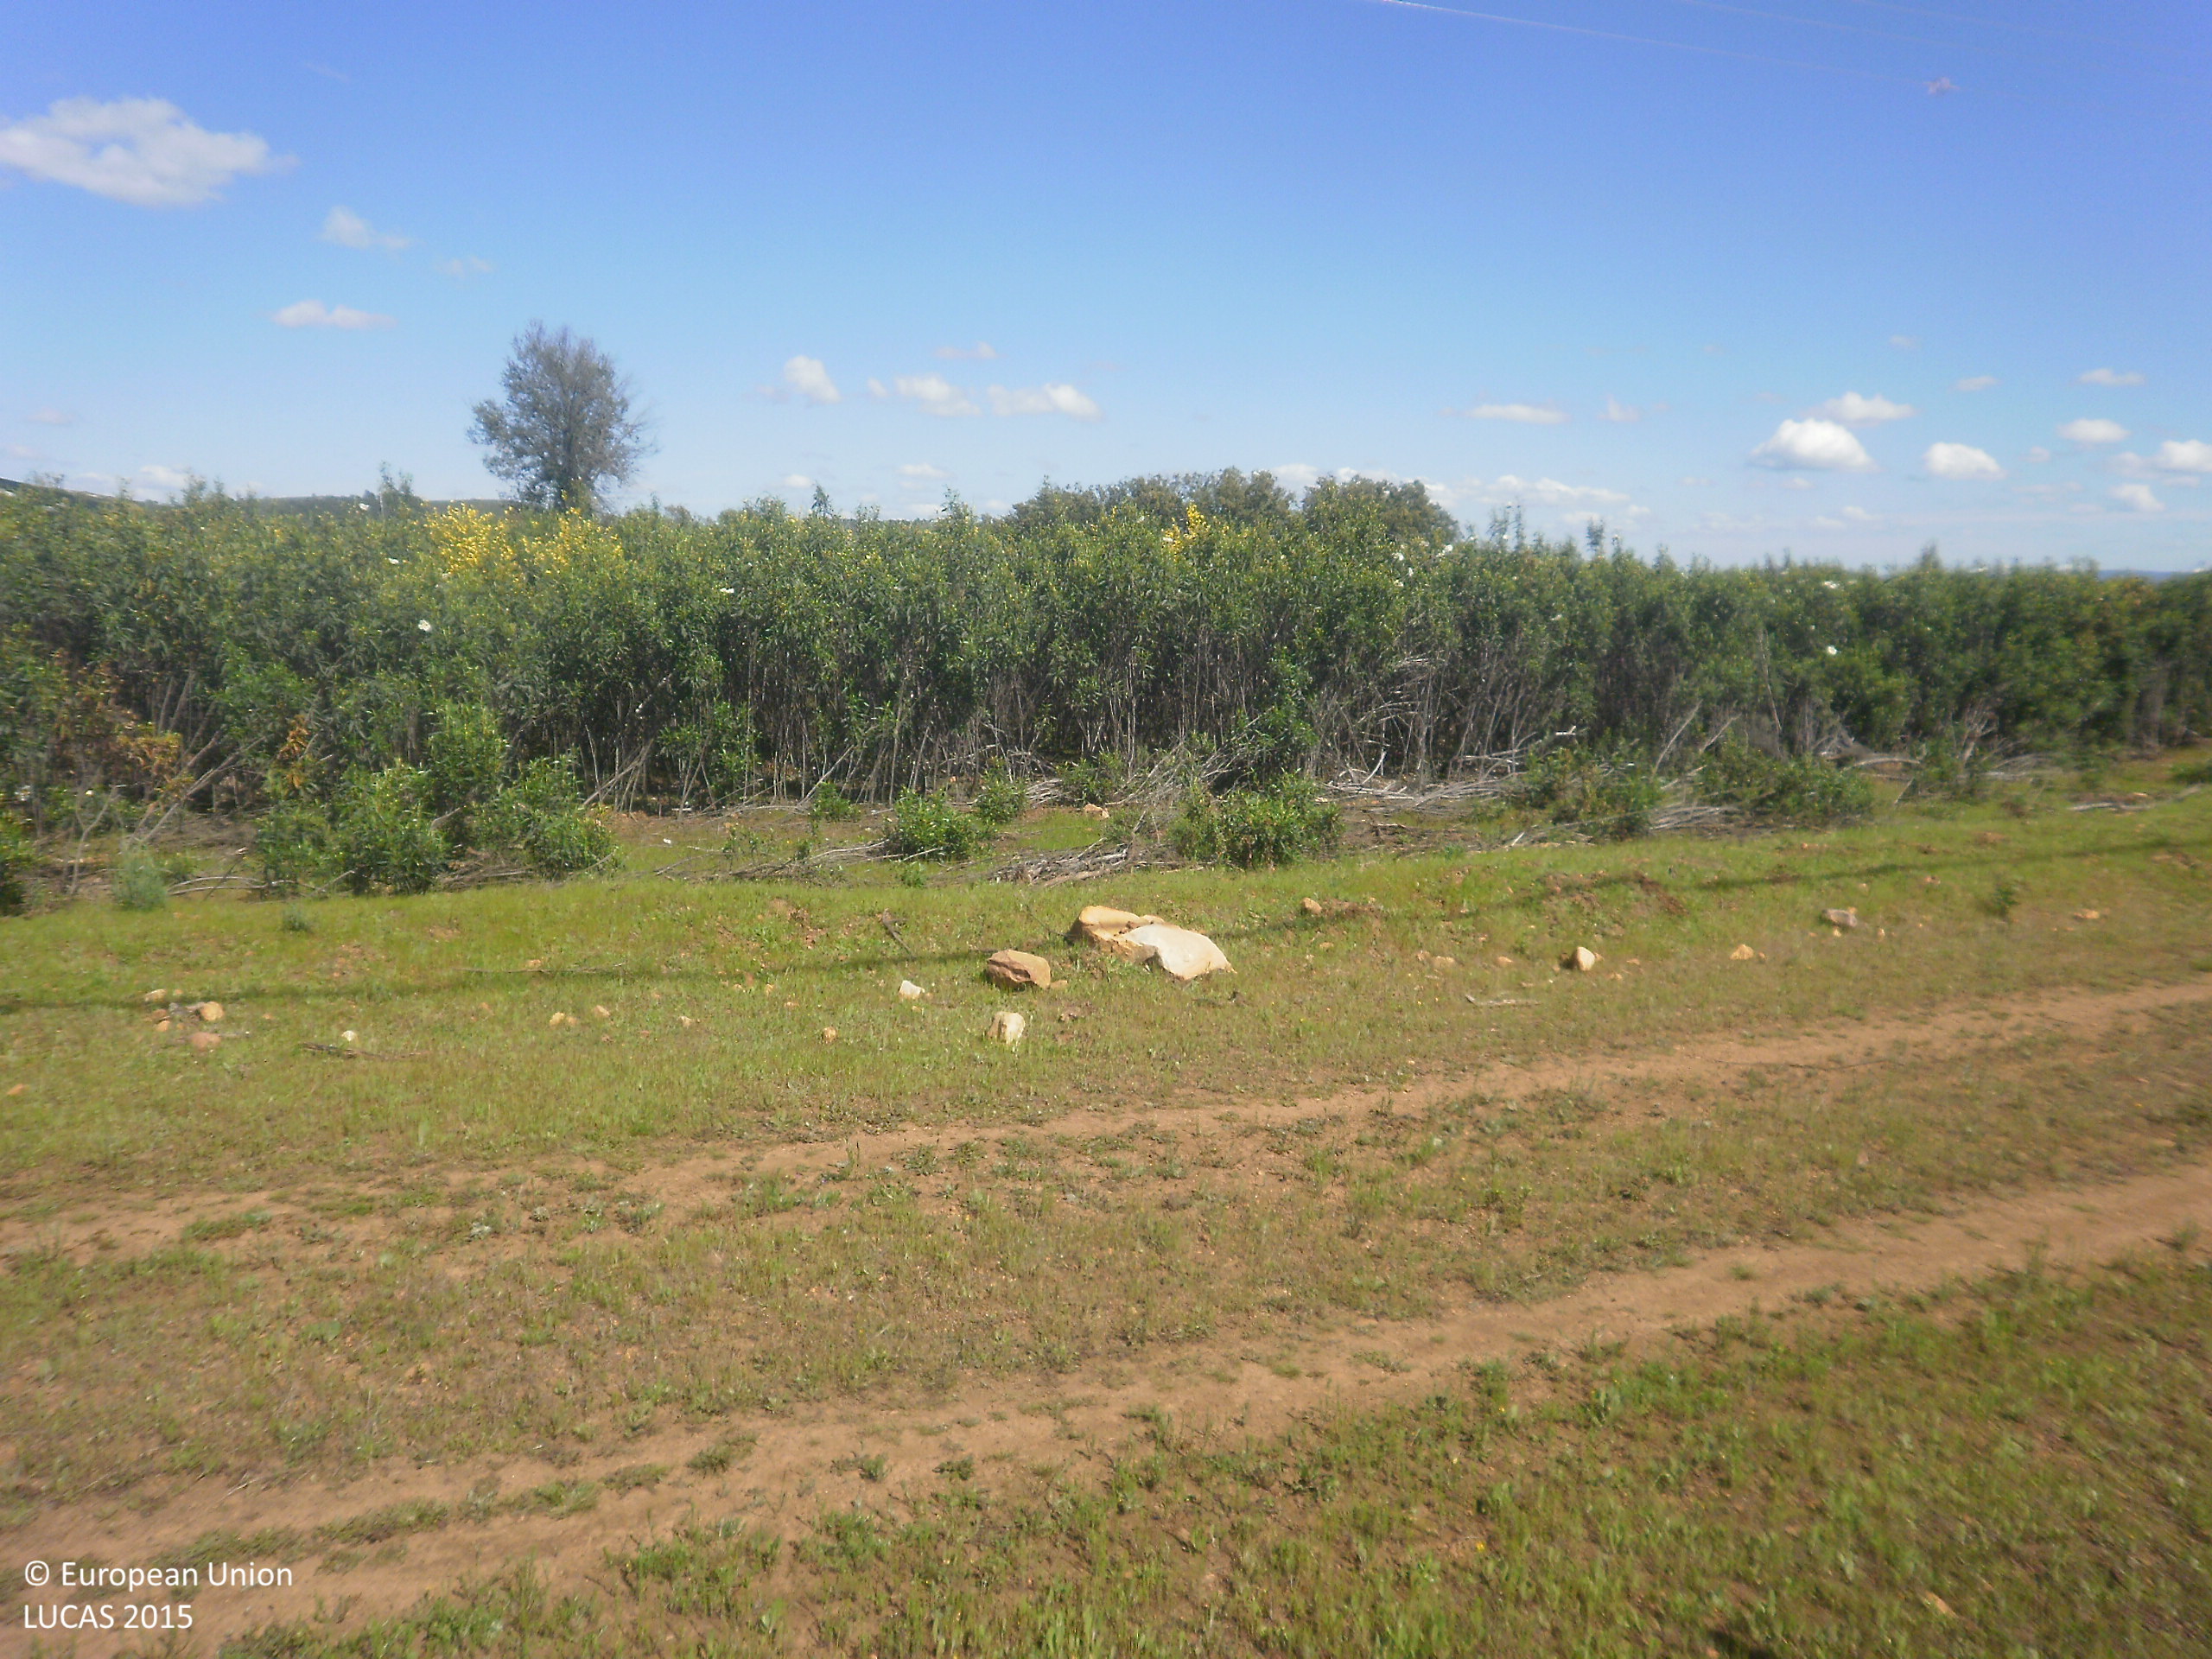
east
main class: Shrubland
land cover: Shrubland with sparse tree cover
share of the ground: > 75 %
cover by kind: shrubs 95 %, broadleaved forest trees 5 %
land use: Semi-natural and natural areas not in use
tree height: > 5 m
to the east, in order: Shrubland with sparse tree cover
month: April
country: ES
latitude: 39.4168
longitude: -5.0144
